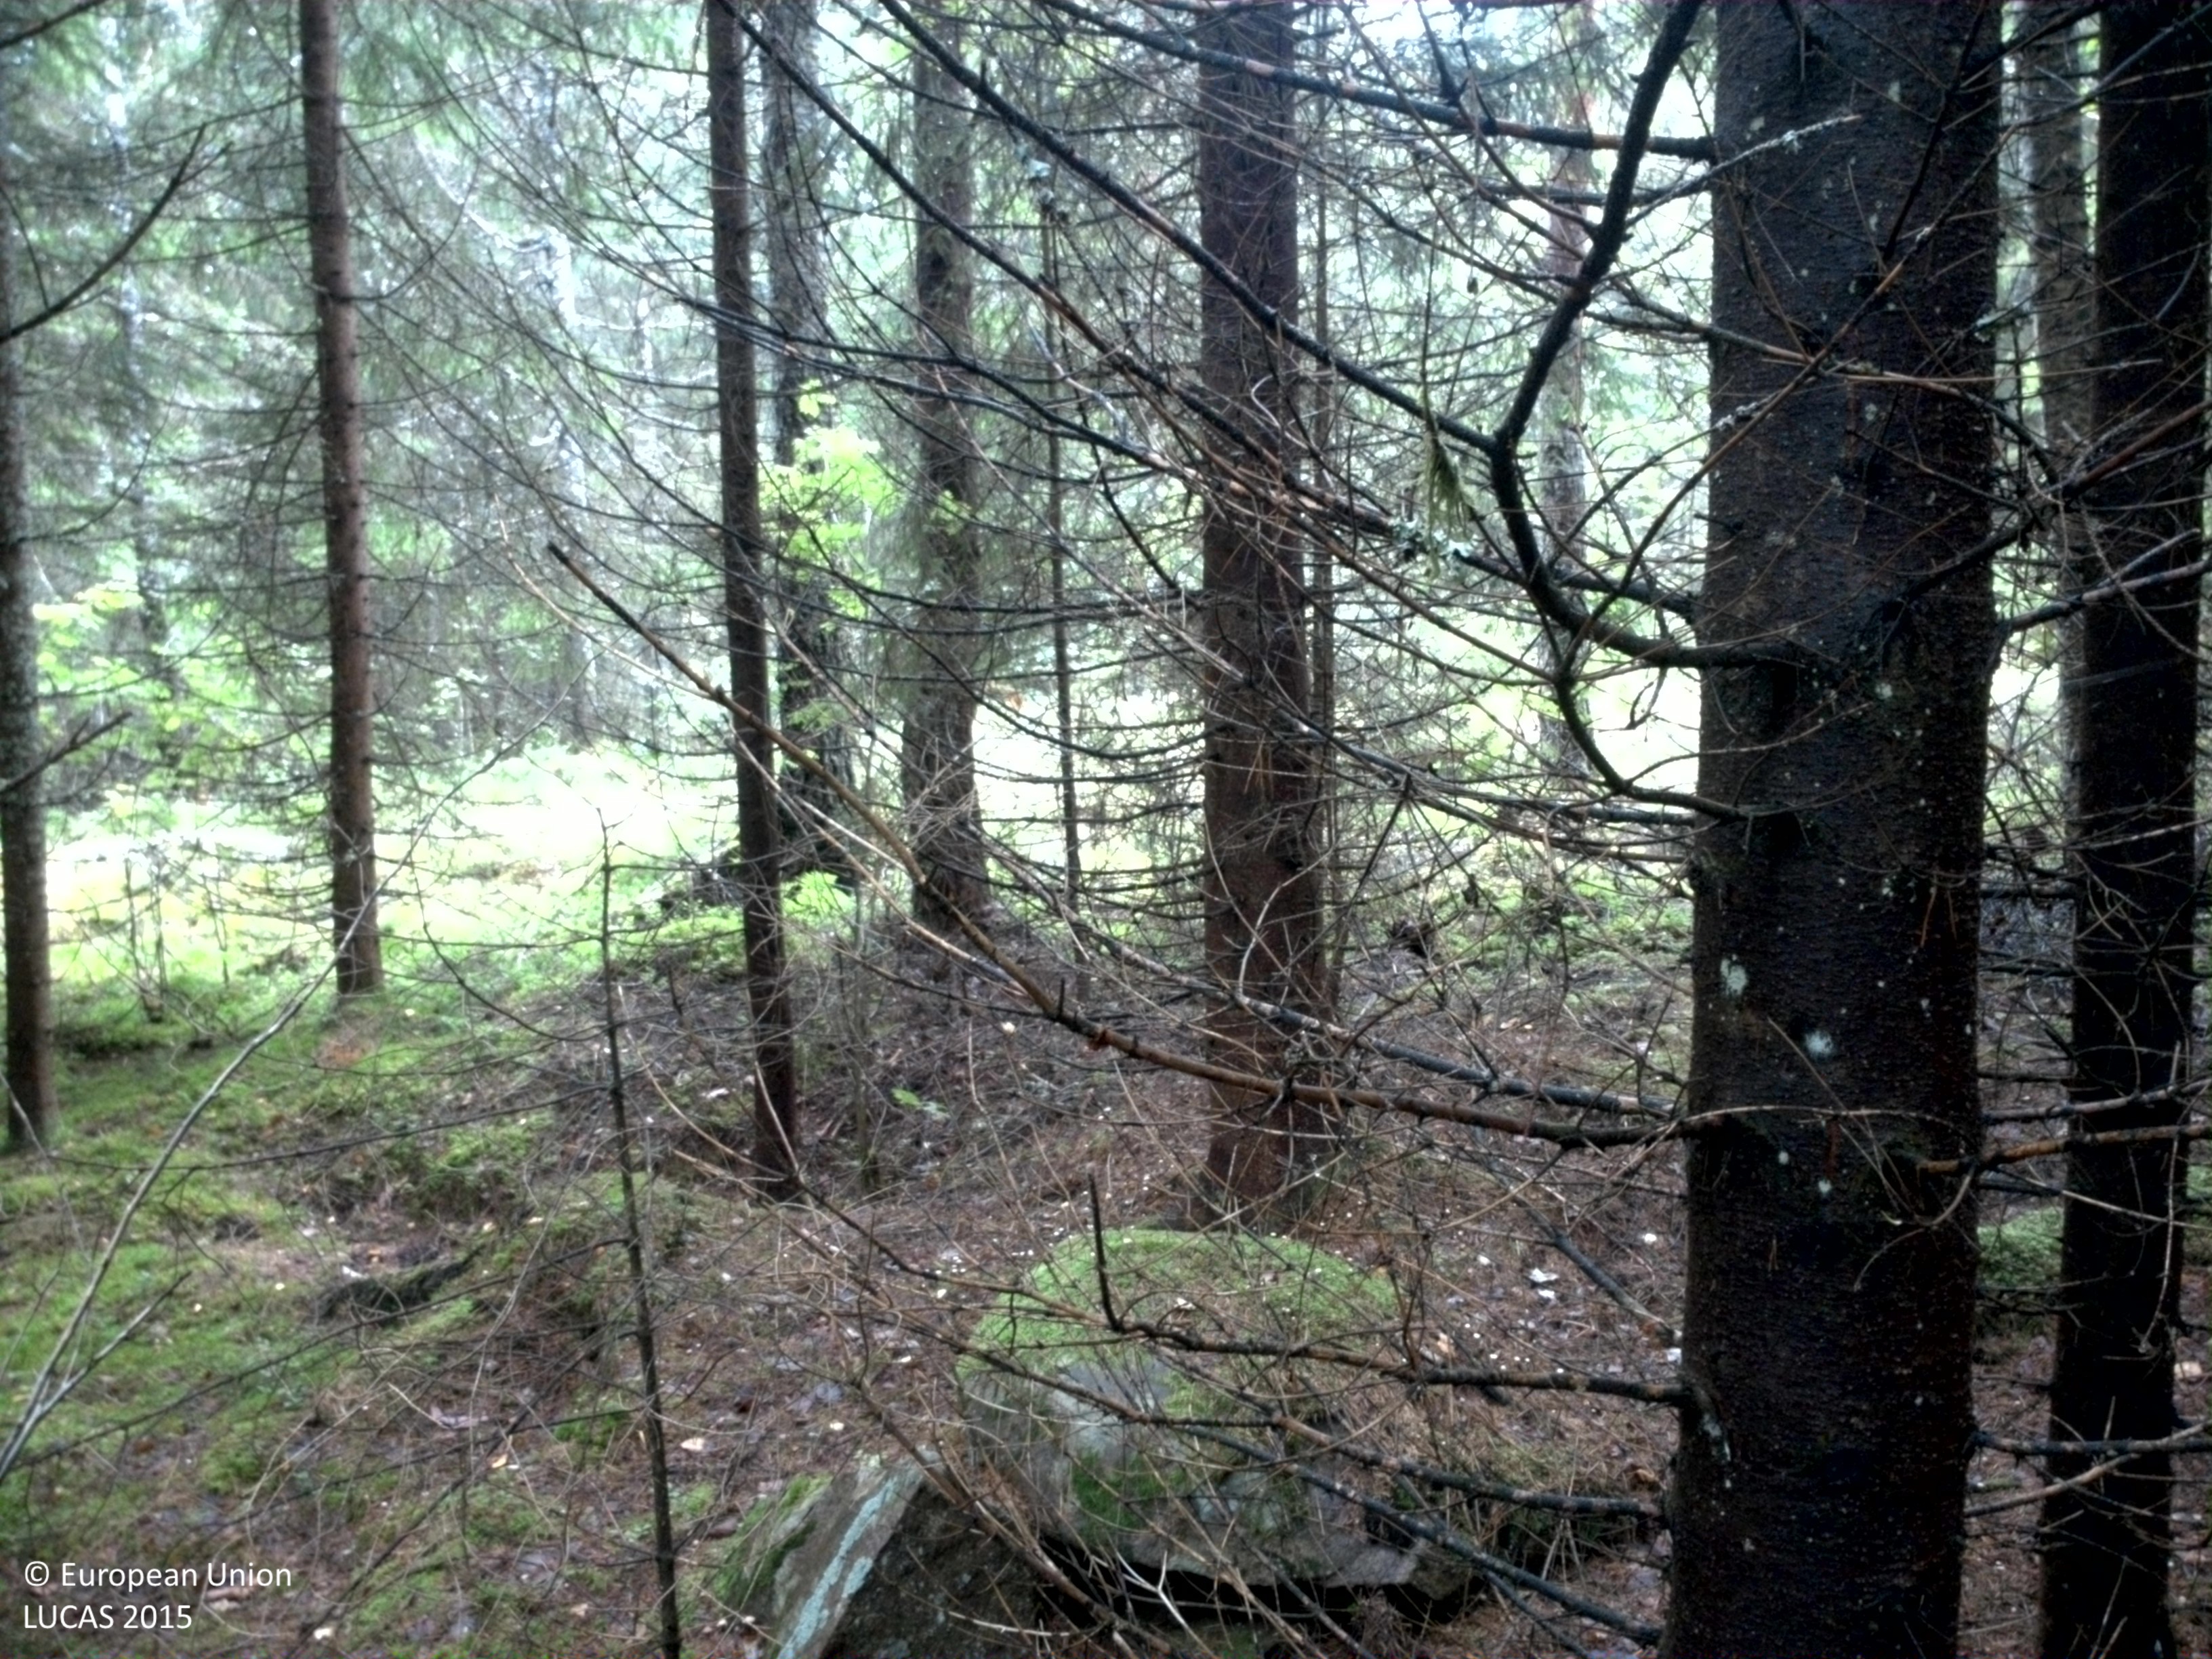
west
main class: Woodland
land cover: Spruce dominated coniferous woodland
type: boreal forest
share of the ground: 50 - 75 %
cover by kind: coniferous forest trees 70 %, lichens and mosses 20 %, broadleaved forest trees 5 %, herbaceous plants 5 %
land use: Forestry
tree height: > 5 m
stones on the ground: < 10 %
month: August
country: SE
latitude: 59.5141
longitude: 13.1909
